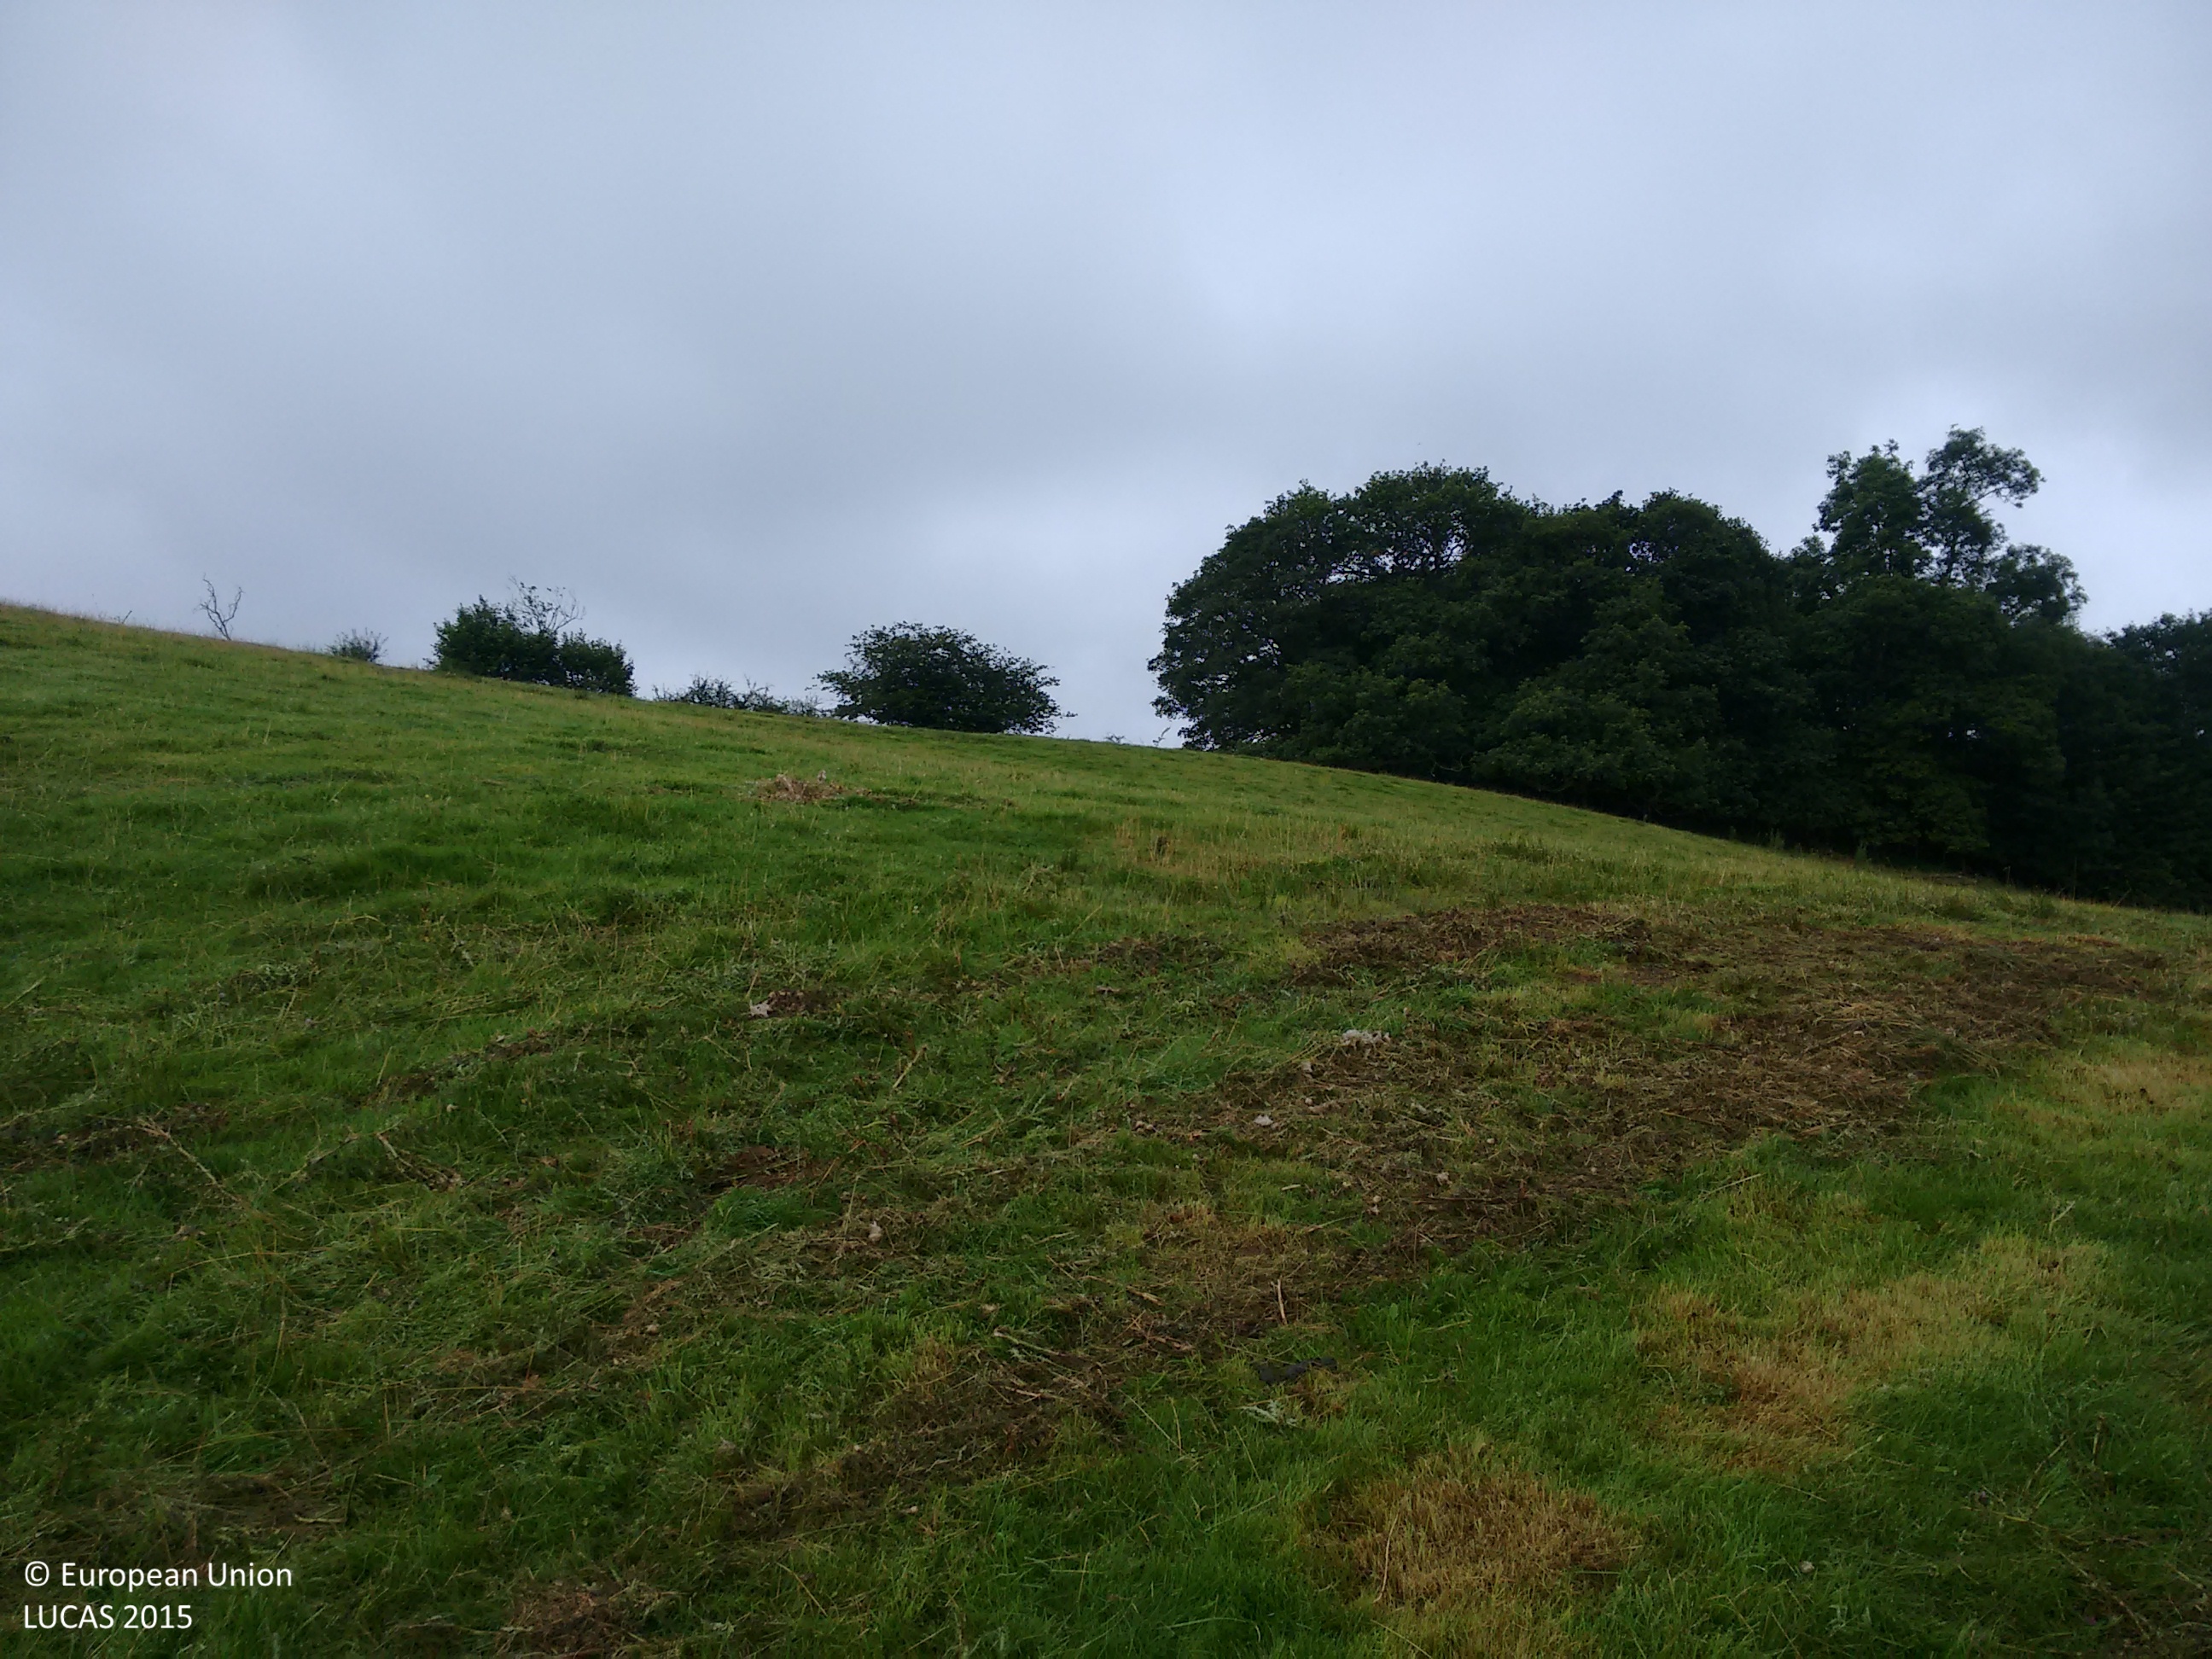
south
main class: Grassland
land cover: Grassland with sparse tree/shrub cover
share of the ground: > 75 %
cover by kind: herbaceous plants 95 %, broadleaved forest trees 5 %
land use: Semi-natural and natural areas not in use
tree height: > 5 m
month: August
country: GB
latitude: 54.6841
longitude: -3.3405
